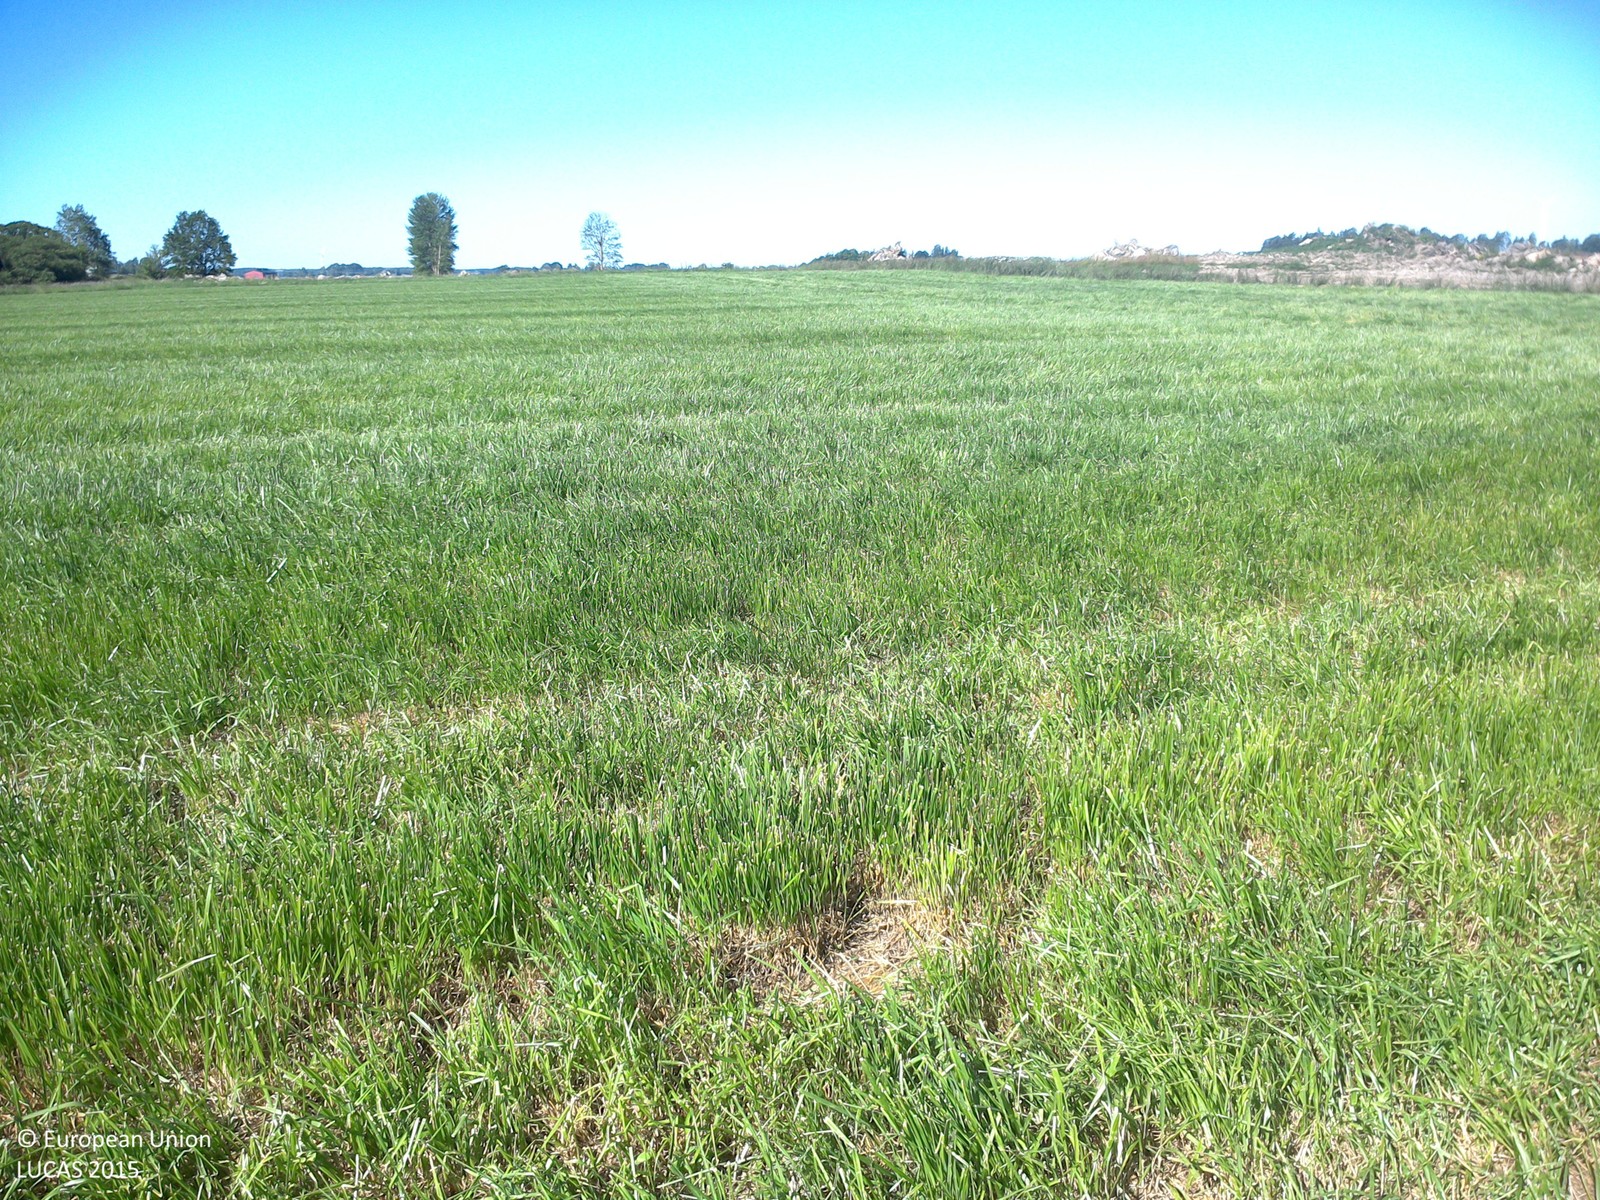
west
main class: Cropland
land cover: Temporary grasslands
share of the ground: > 75 %
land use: Agriculture (excluding fallow land and kitchen gardens)
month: July
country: SE
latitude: 58.4208
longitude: 15.3187
